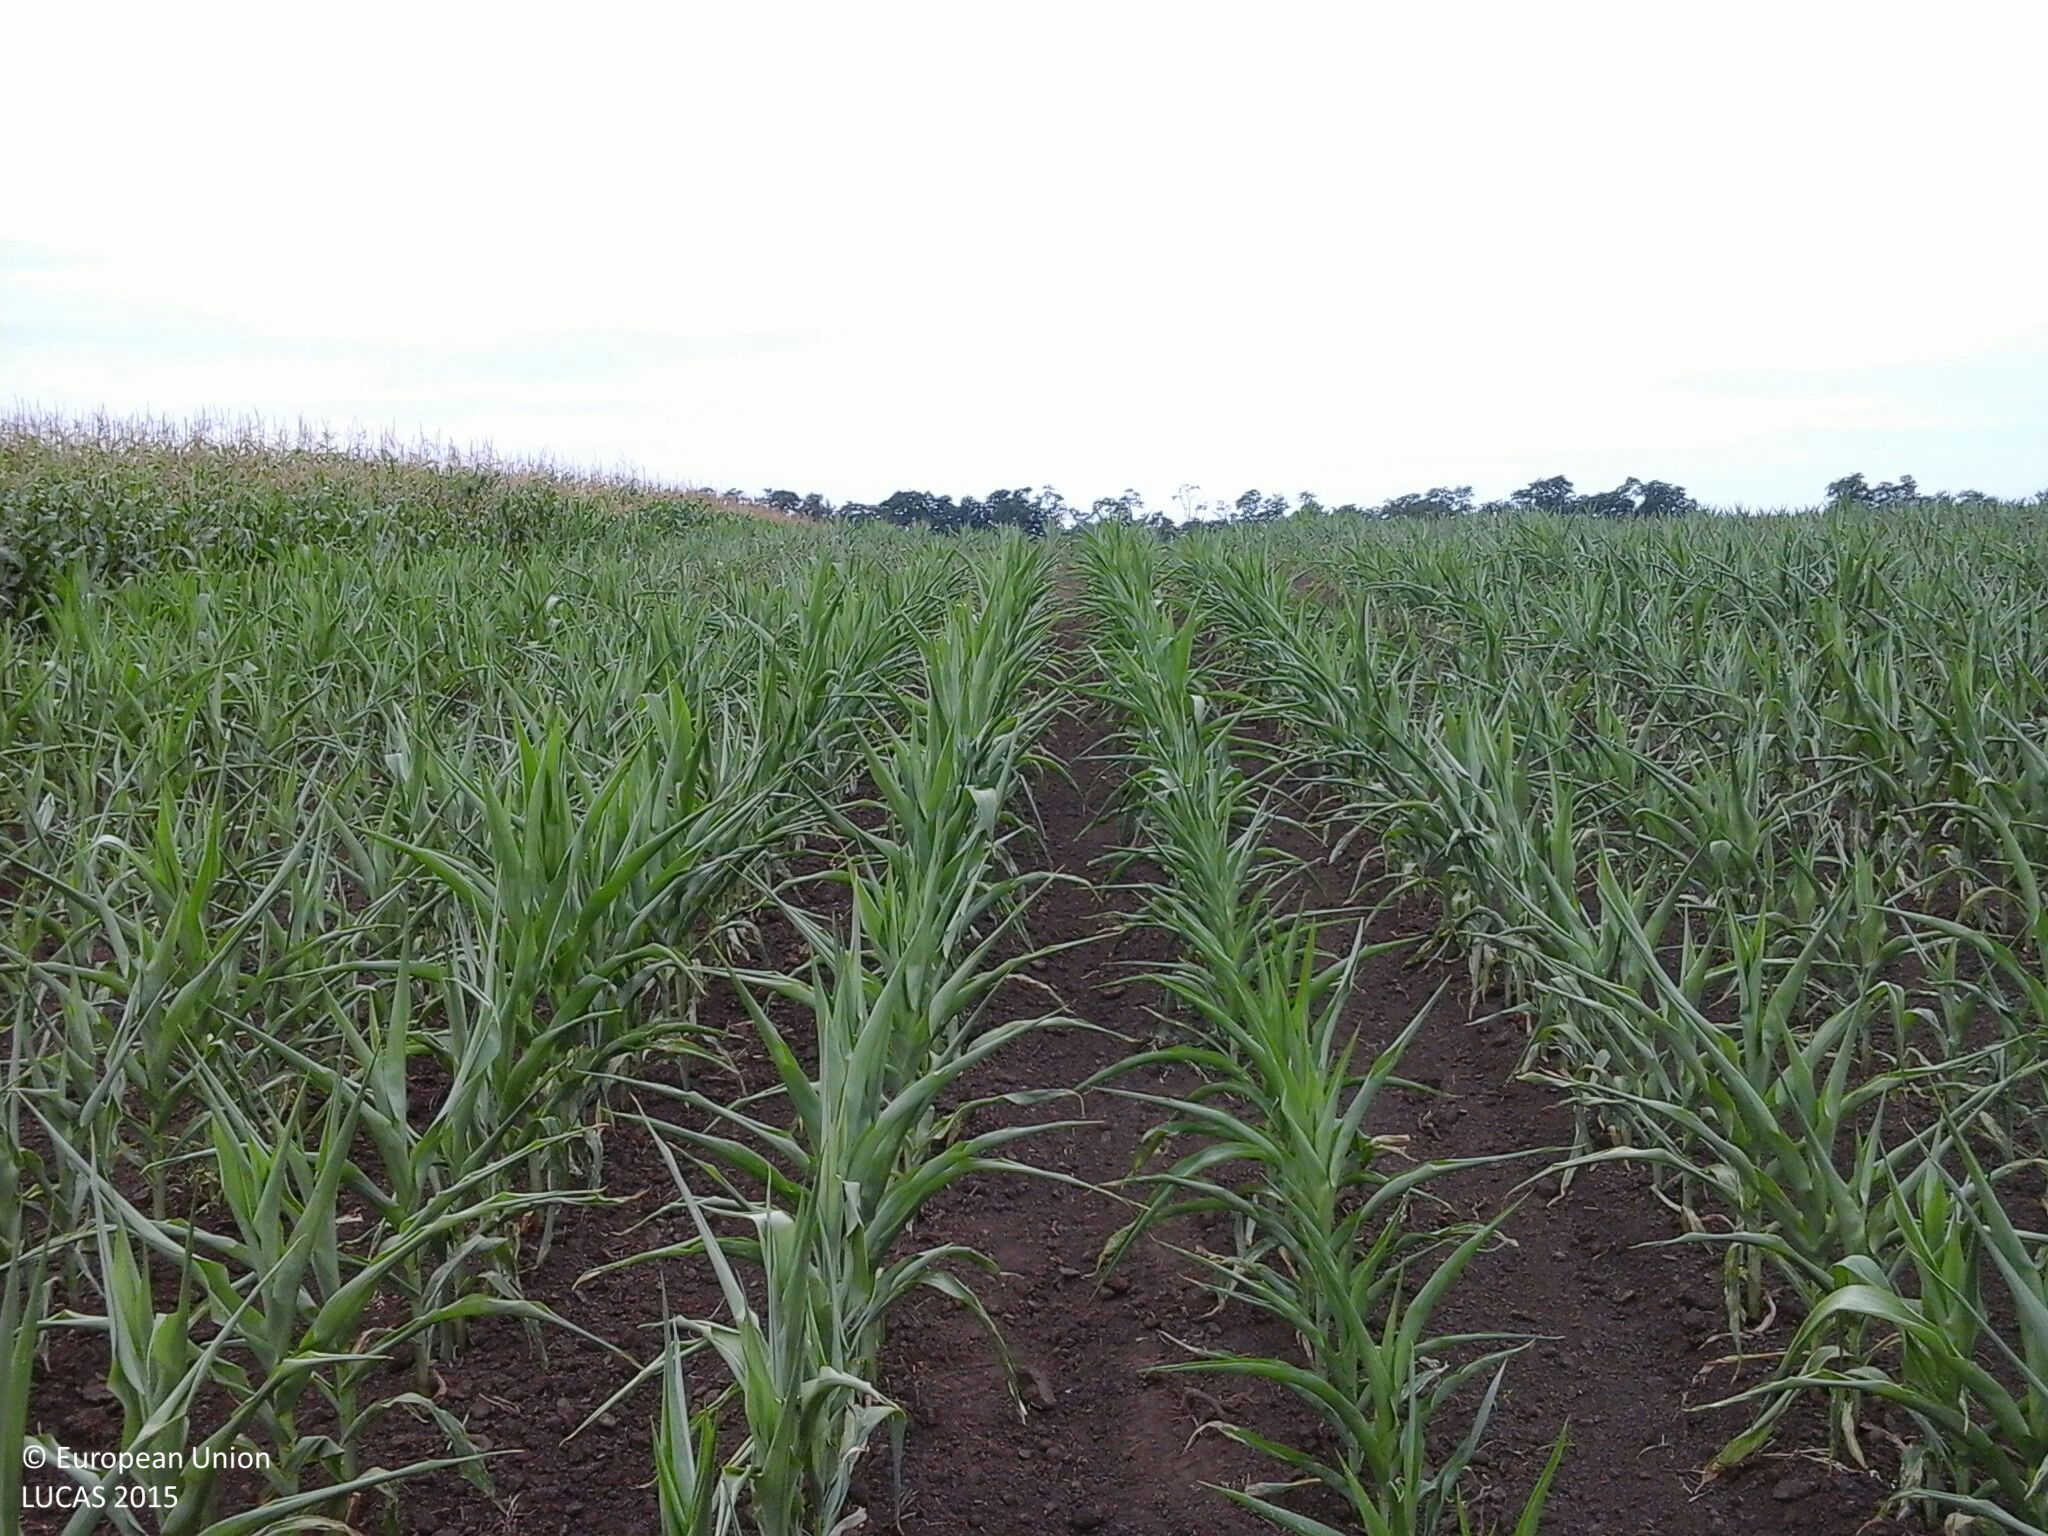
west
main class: Cropland
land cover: Maize
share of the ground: > 75 %
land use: Agriculture (excluding fallow land and kitchen gardens)
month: July
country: HU
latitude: 47.8736
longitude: 21.5027
